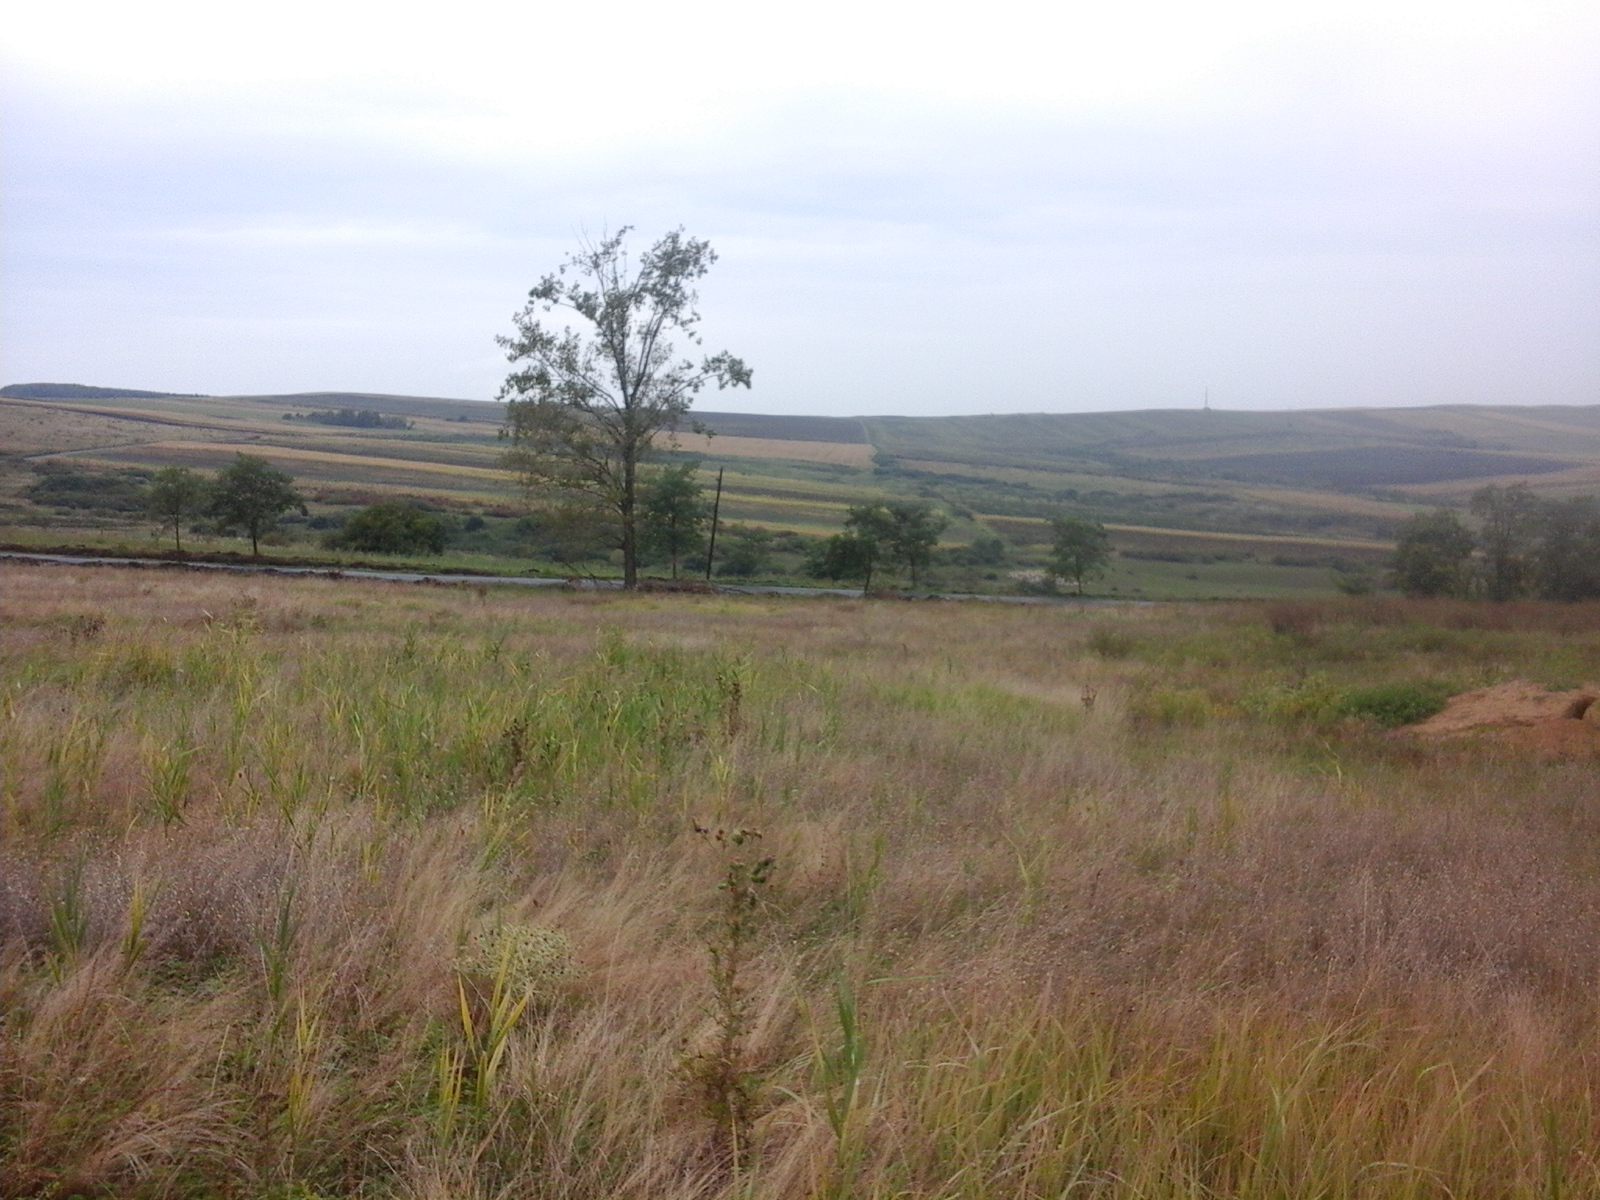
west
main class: Grassland
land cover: Grassland without tree/shrub cover
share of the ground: > 75 %
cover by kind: herbaceous plants 100 %
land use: Agriculture (excluding fallow land and kitchen gardens)
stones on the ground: < 10 %
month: September
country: RO
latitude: 47.2752
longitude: 22.6291
